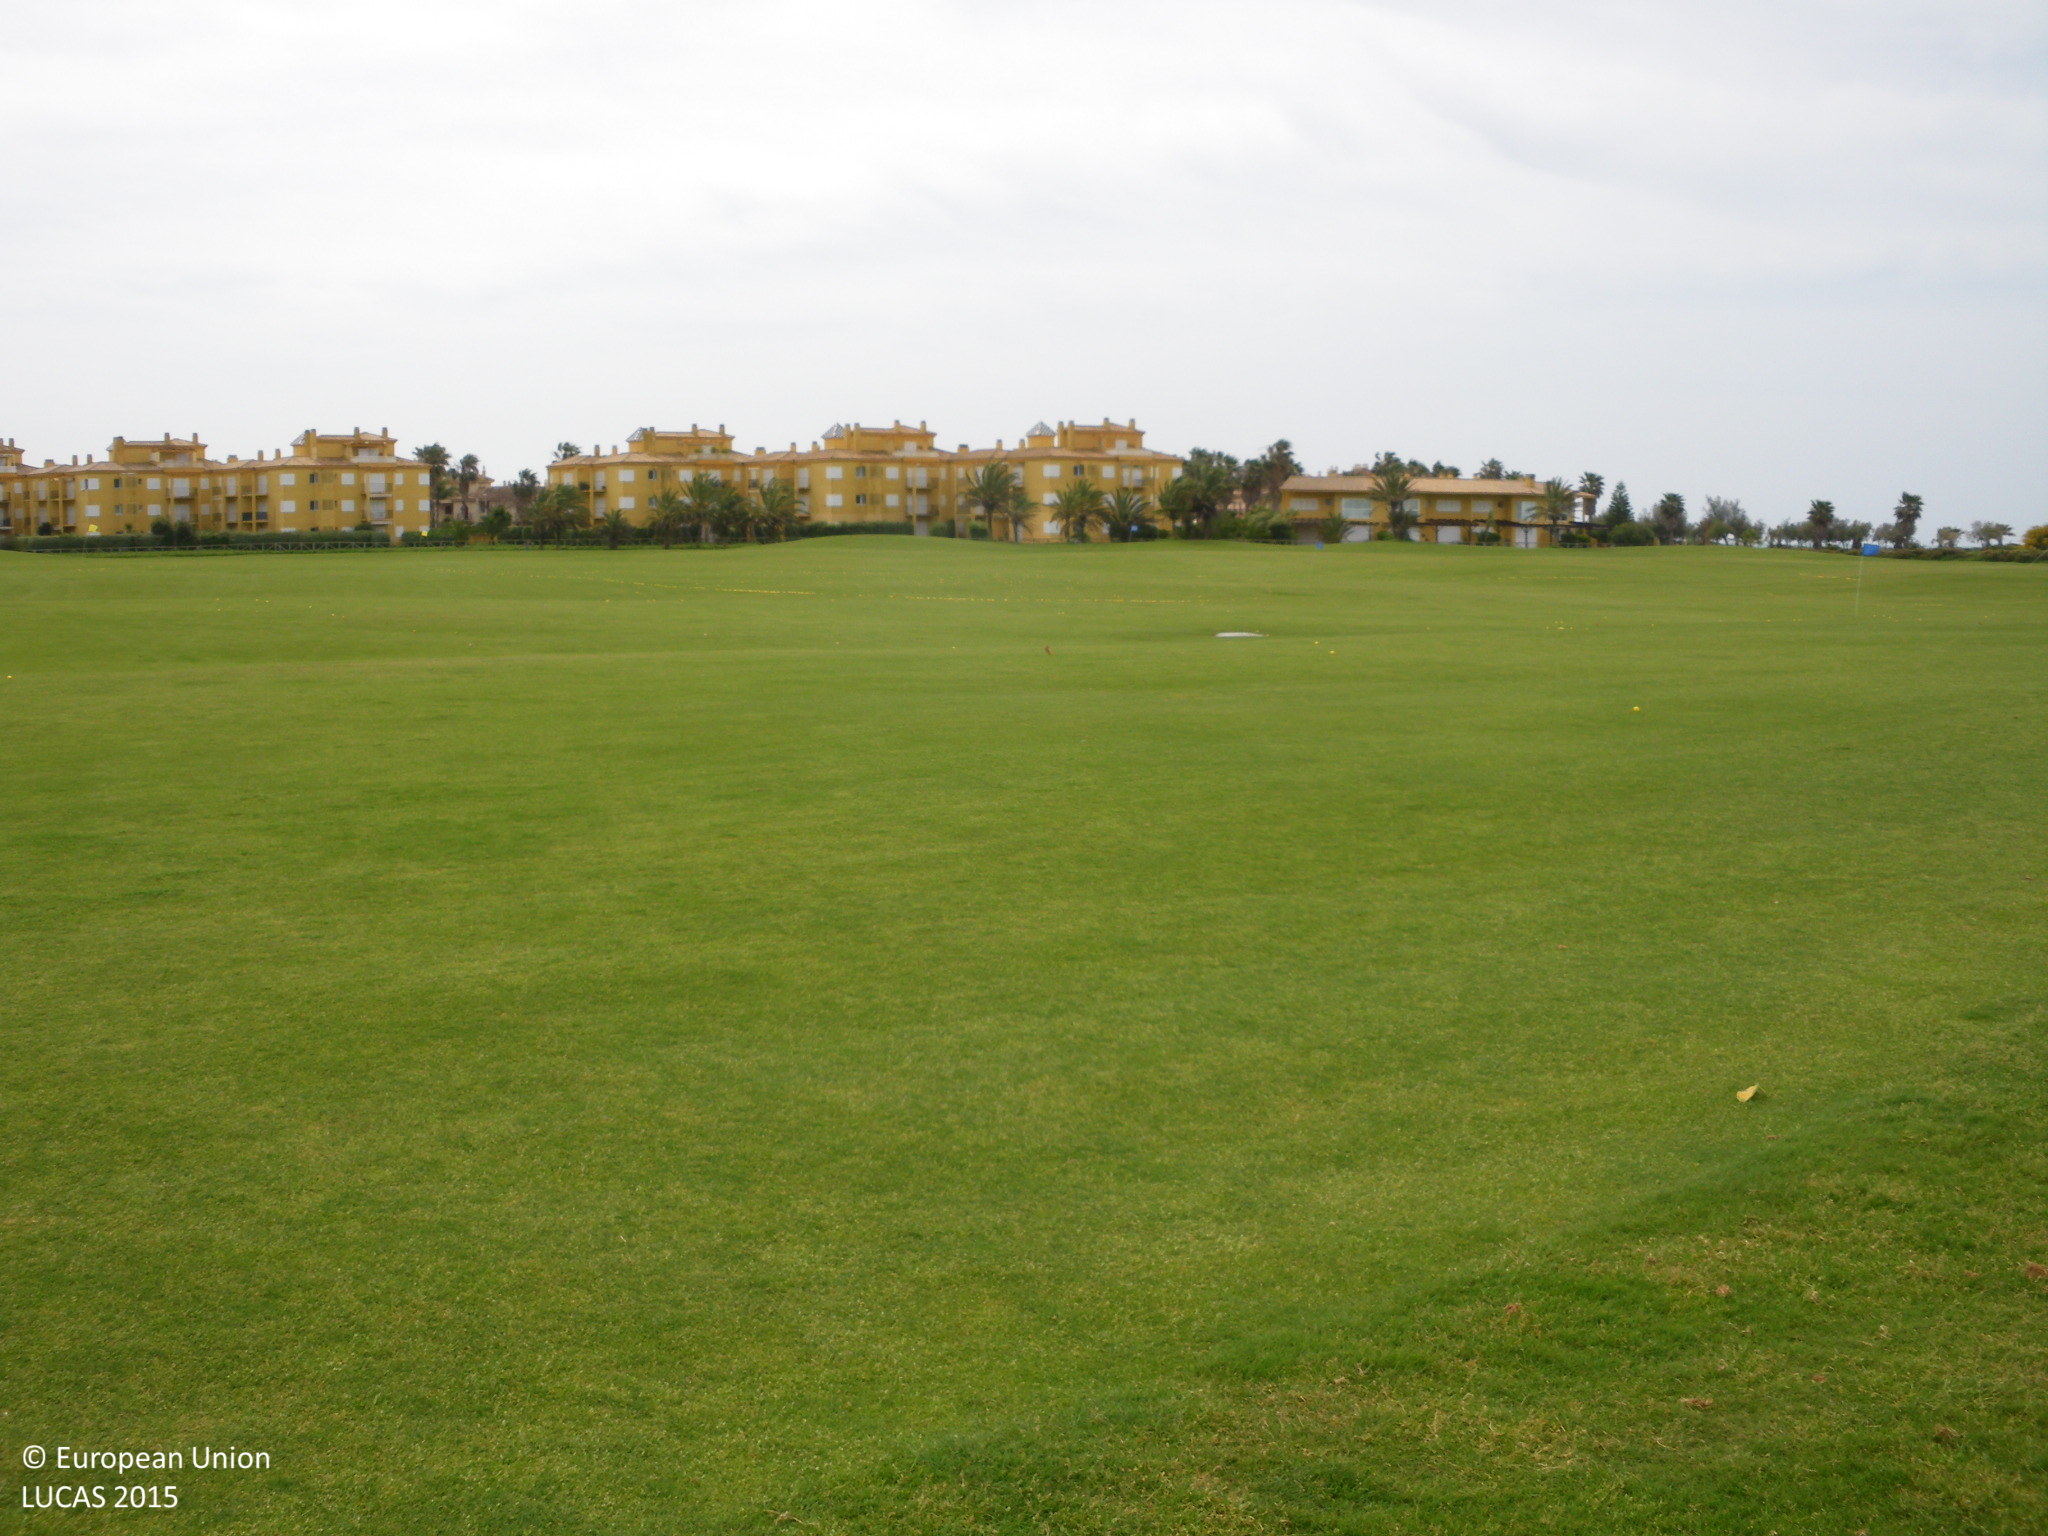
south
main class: Grassland
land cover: Grassland without tree/shrub cover
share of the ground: > 75 %
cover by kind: herbaceous plants 100 %
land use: Sport
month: April
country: ES
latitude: 36.6805
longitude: -6.4105
